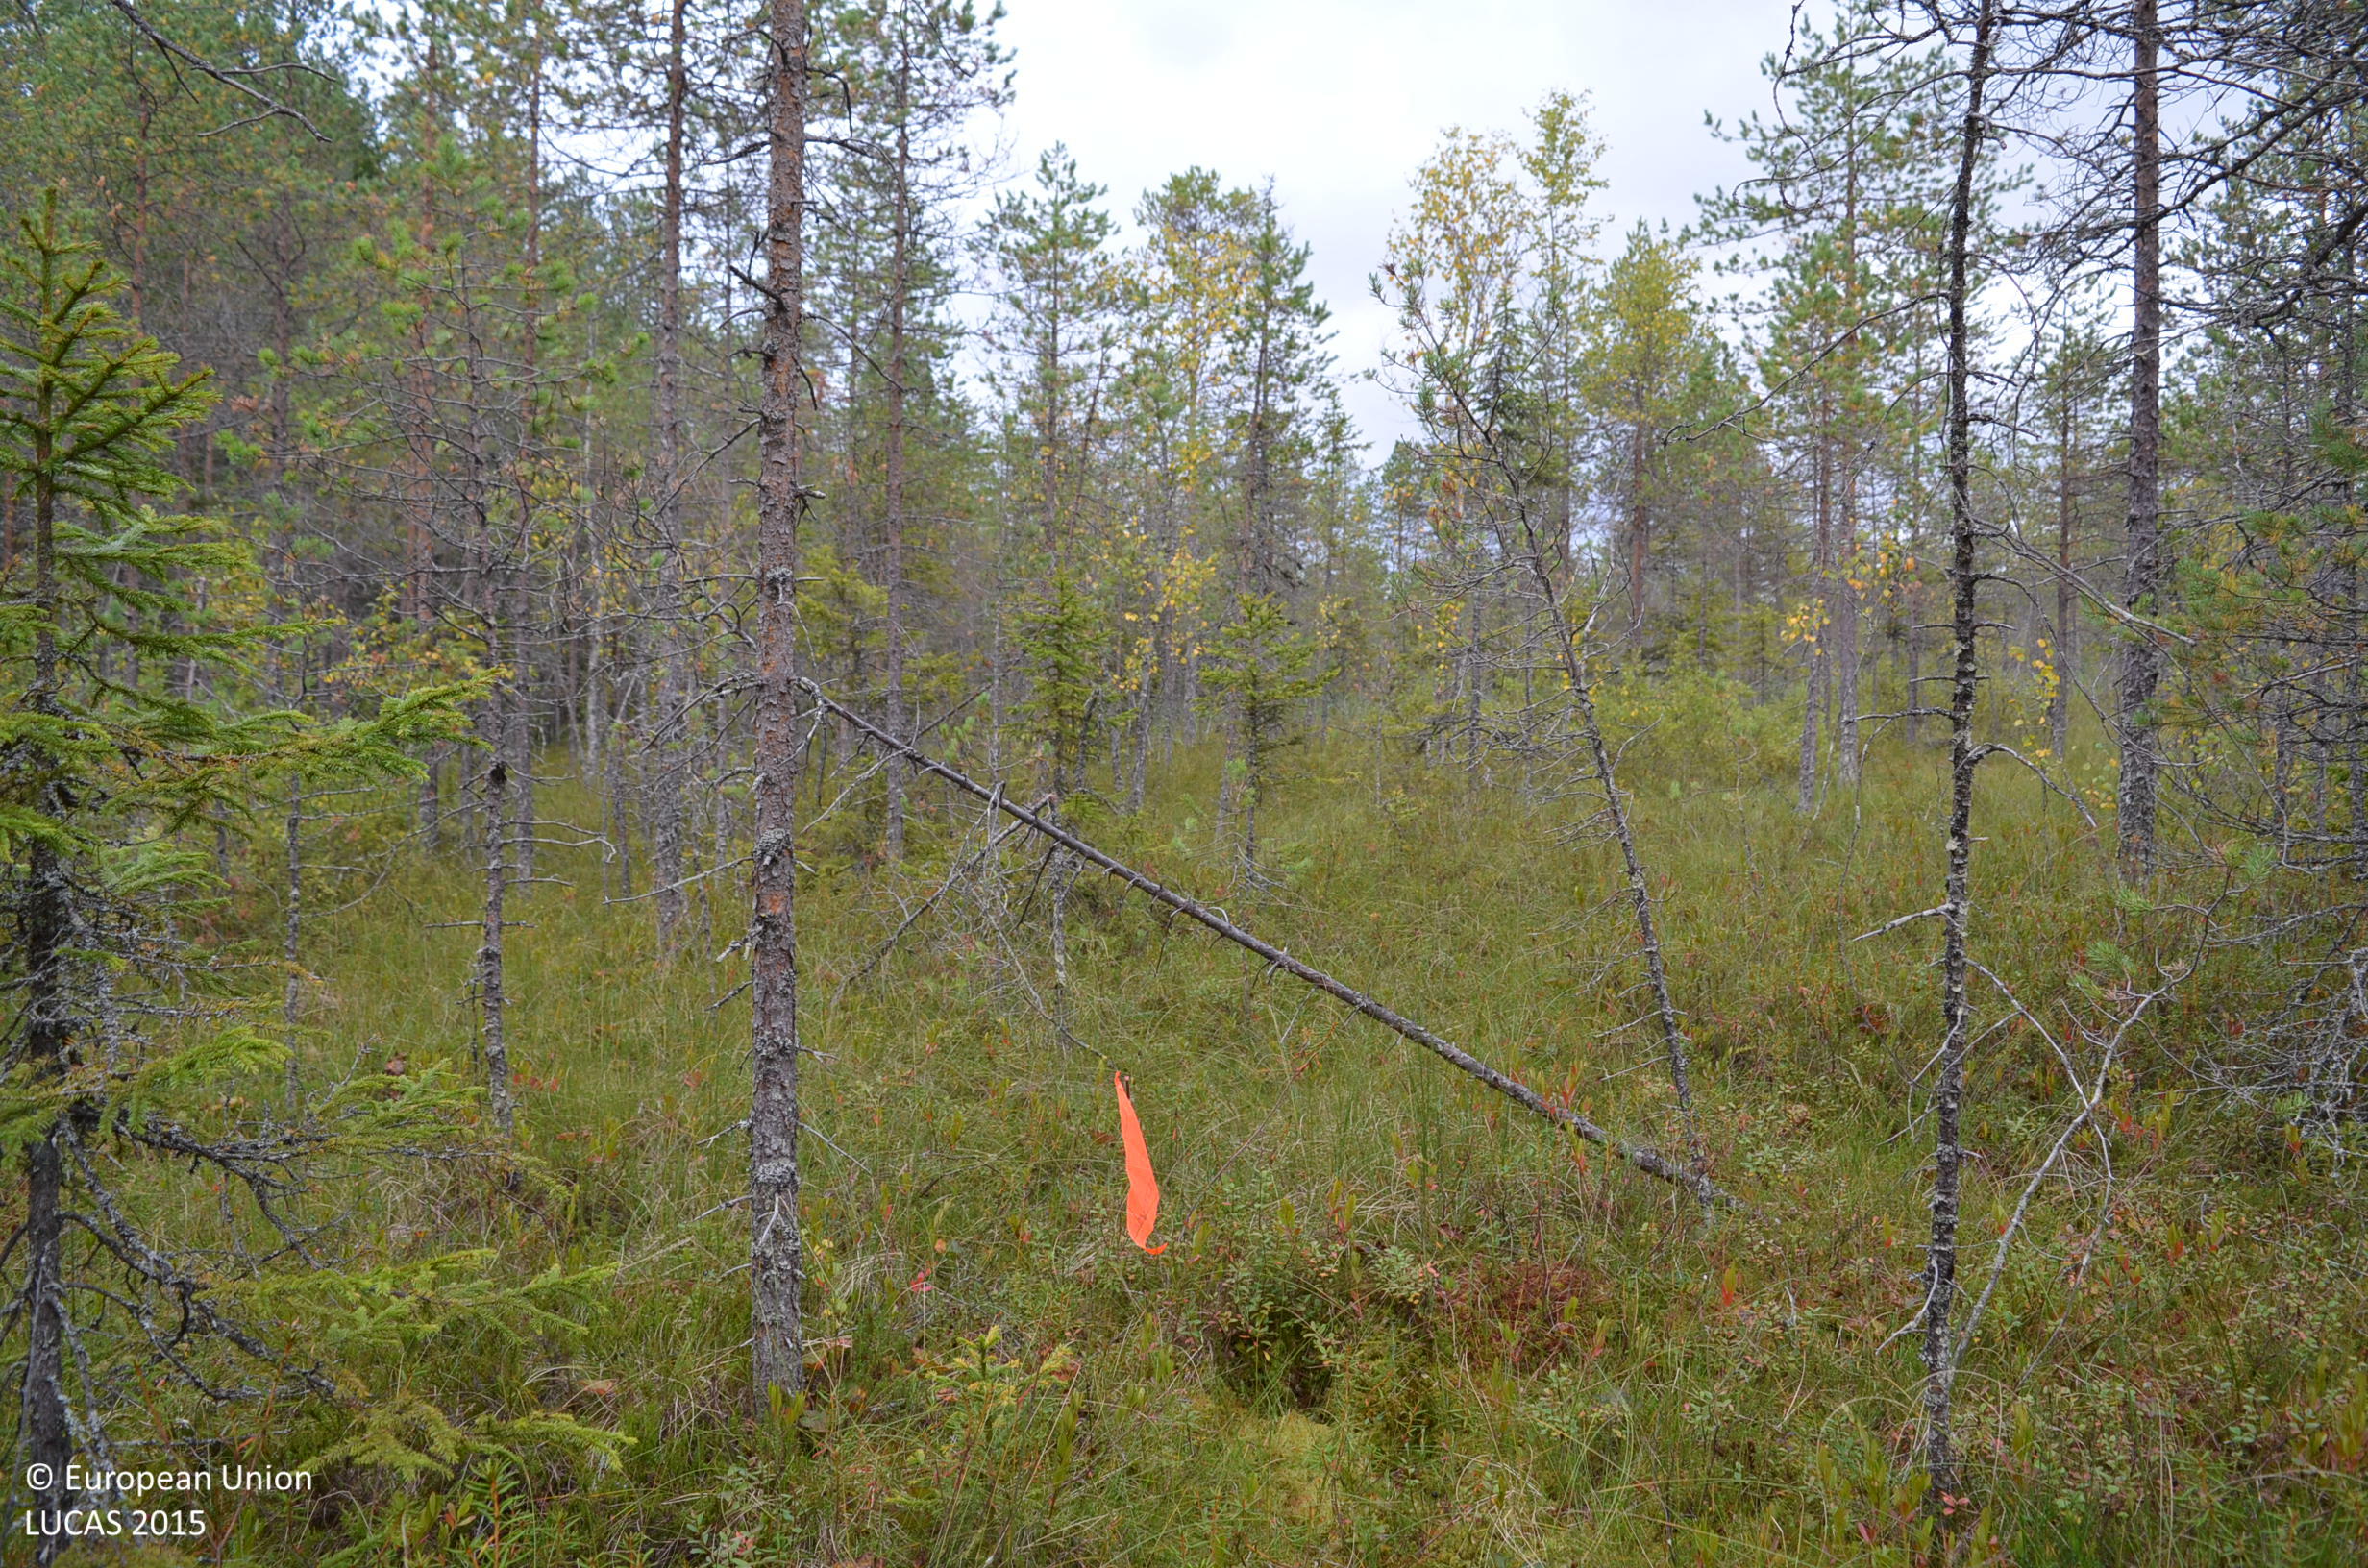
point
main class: Woodland
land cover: Pine dominated coniferous woodland
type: mire and swamp forests
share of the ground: 50 - 75 %
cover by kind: coniferous forest trees 45 %, shrubs 35 %, broadleaved forest trees 10 %, herbaceous plants 5 %, lichens and mosses 5 %
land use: Semi-natural and natural areas not in use
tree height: > 5 m
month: September
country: FI
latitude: 62.7888
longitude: 24.4945
